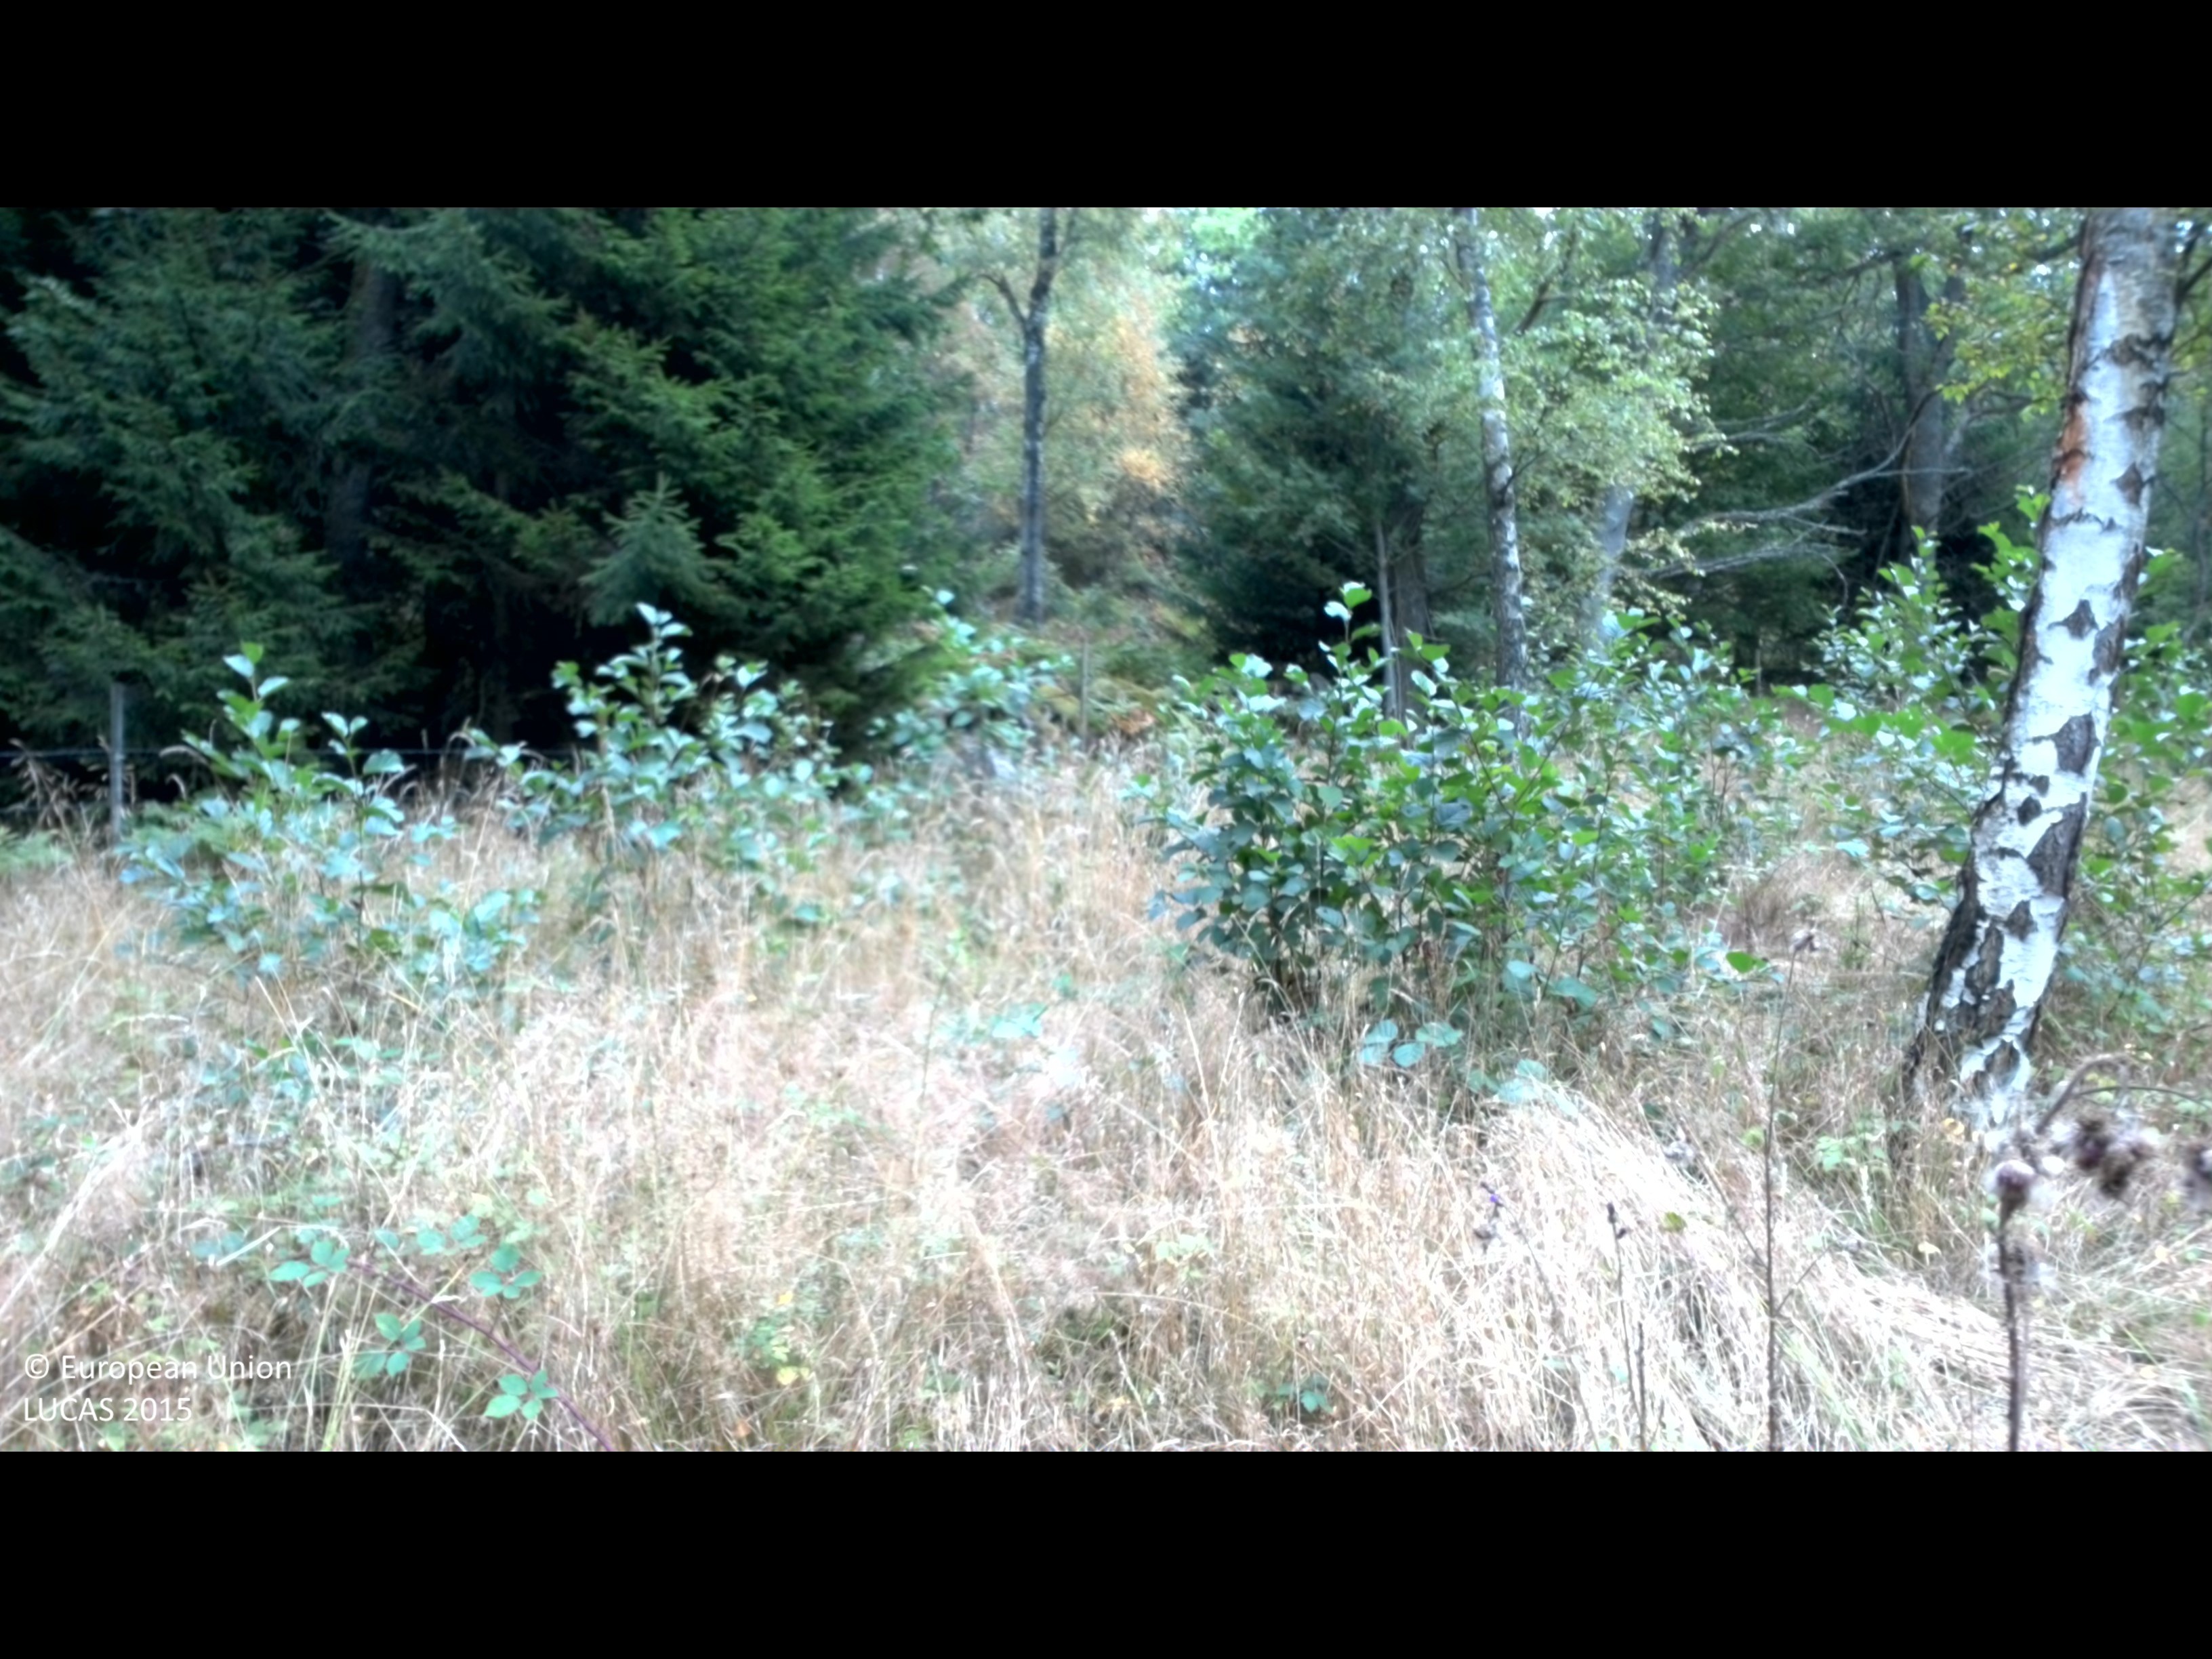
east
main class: Woodland
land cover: Broadleaved woodland
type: hemiboreal forest and nemoral coniferous forest and mixed broadleaved-coniferous forest
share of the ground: 10 - 25 %
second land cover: Grassland without tree/shrub cover
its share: > 75 %
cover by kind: herbaceous plants 60 %, broadleaved forest trees 25 %, shrubs 15 %
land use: Forestry
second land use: Agriculture (excluding fallow land and kitchen gardens)
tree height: > 5 m
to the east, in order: Broadleaved woodland; Grassland without tree/shrub cover; Fences; Broadleaved woodland; Rocks and stones; Spruce dominated coniferous woodland; Dry stone walls; Spruce dominated coniferous woodland; Broadleaved woodland; Inland marshes; Abandoned hedges; Inland marshes; Broadleaved woodland; Grassland with sparse tree/shrub cover
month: August
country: SE
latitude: 56.1811
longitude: 15.4286
